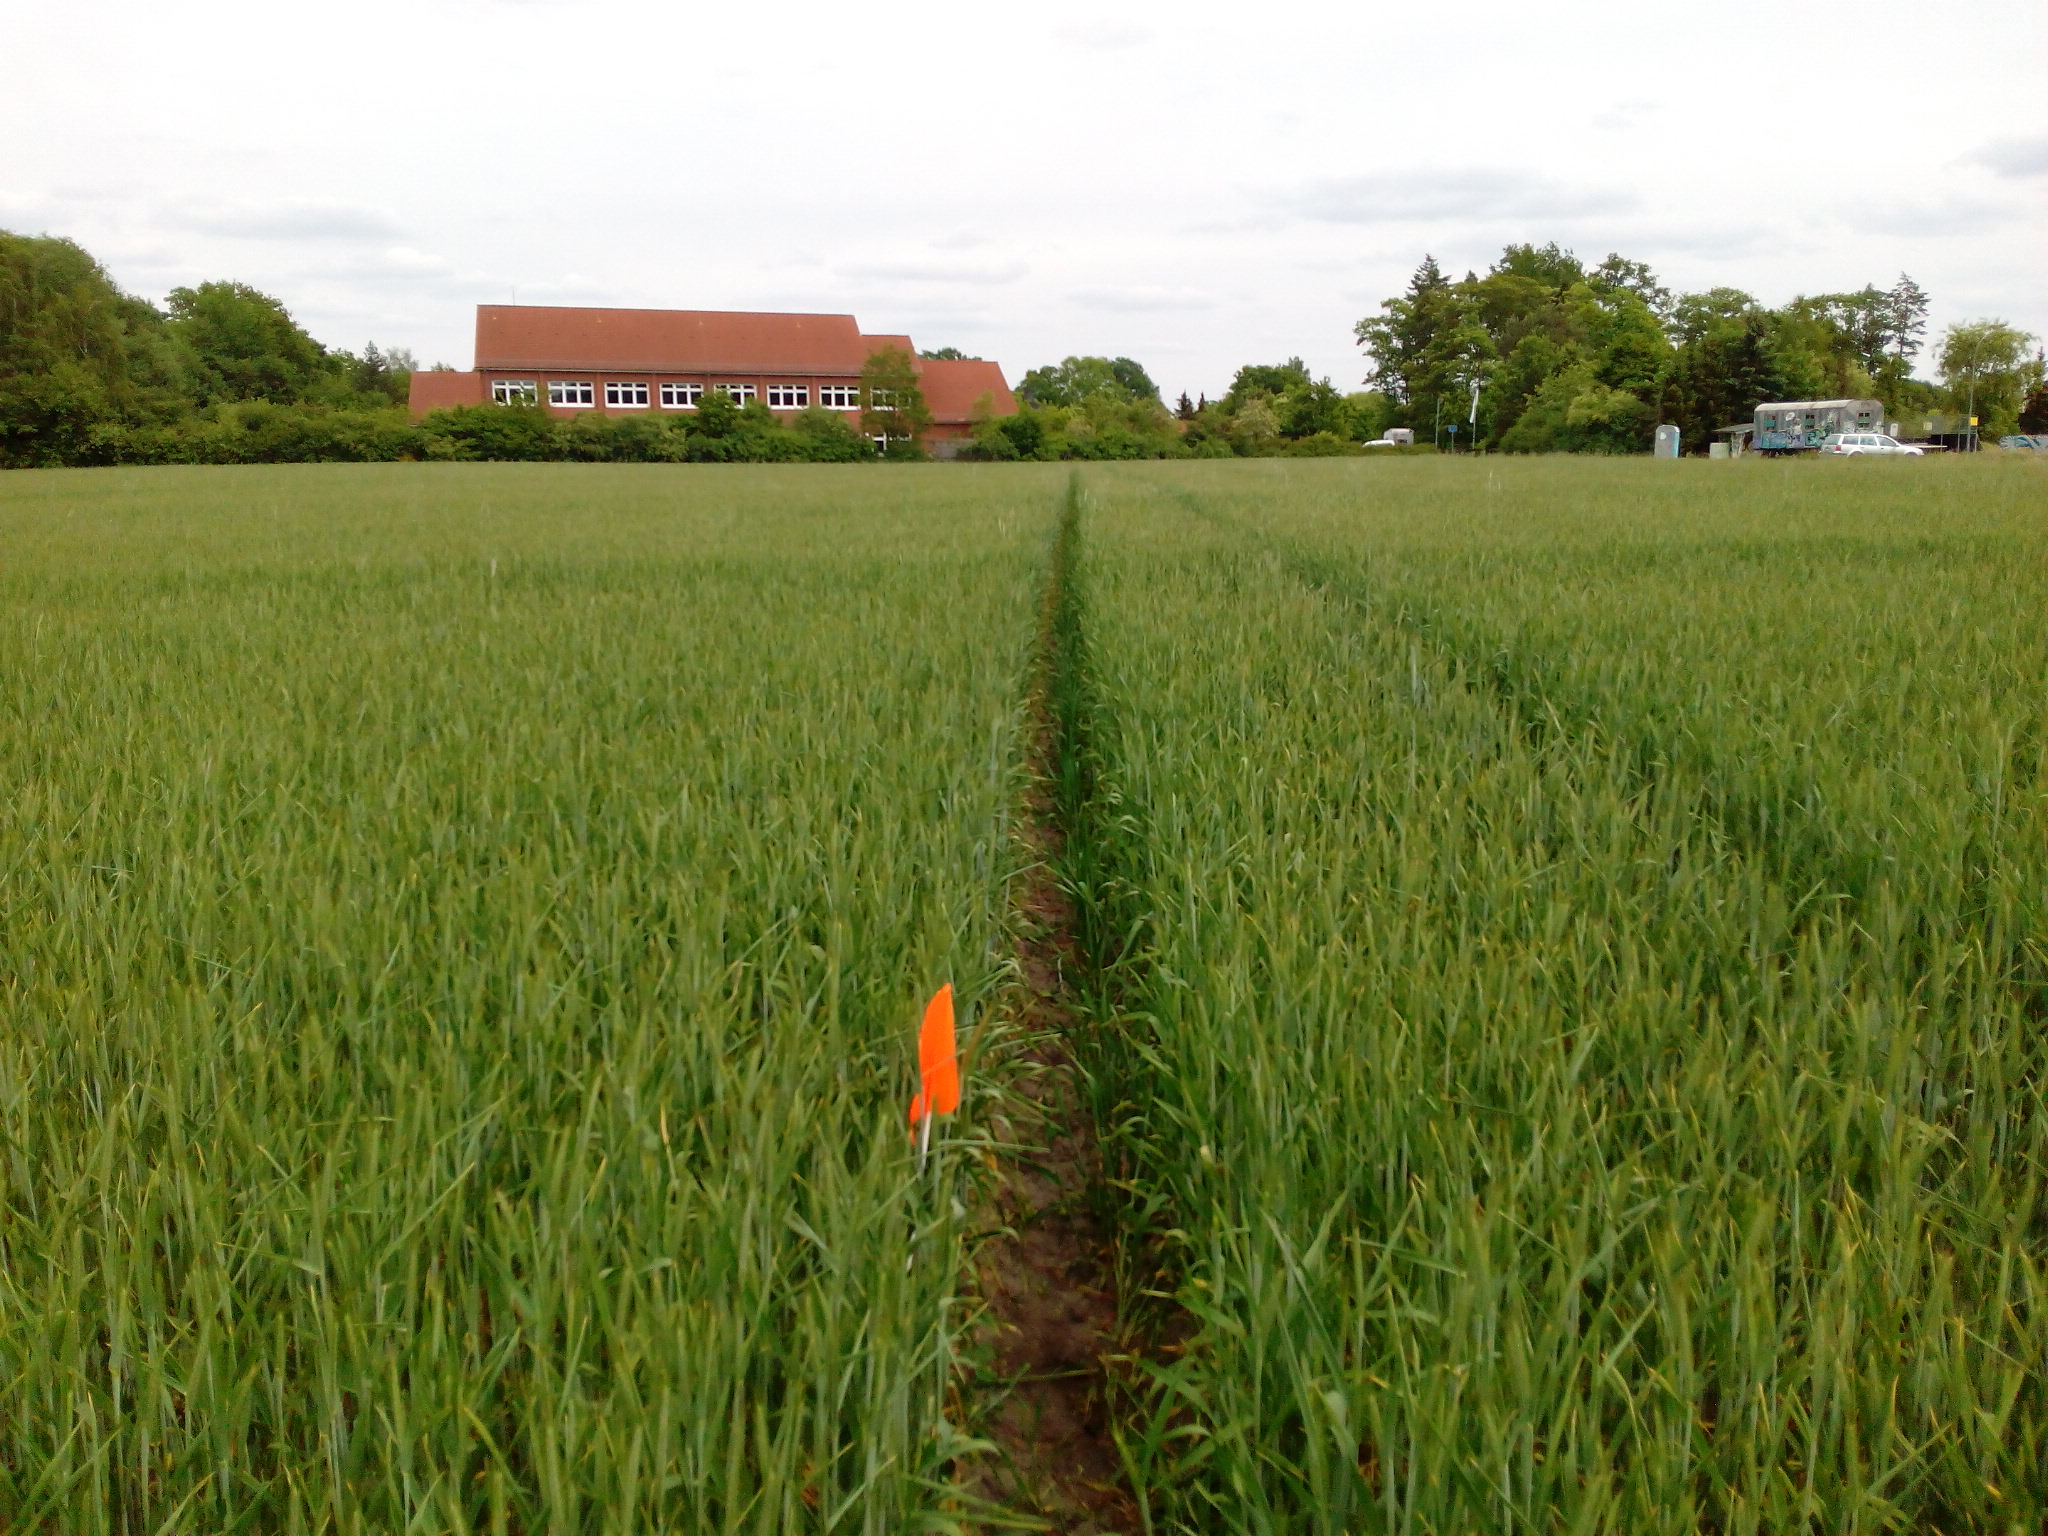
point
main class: Cropland
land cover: Rye
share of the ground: > 75 %
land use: Agriculture (excluding fallow land and kitchen gardens)
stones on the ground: < 10 %
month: June
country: DE
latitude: 52.6830
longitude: 9.8965
